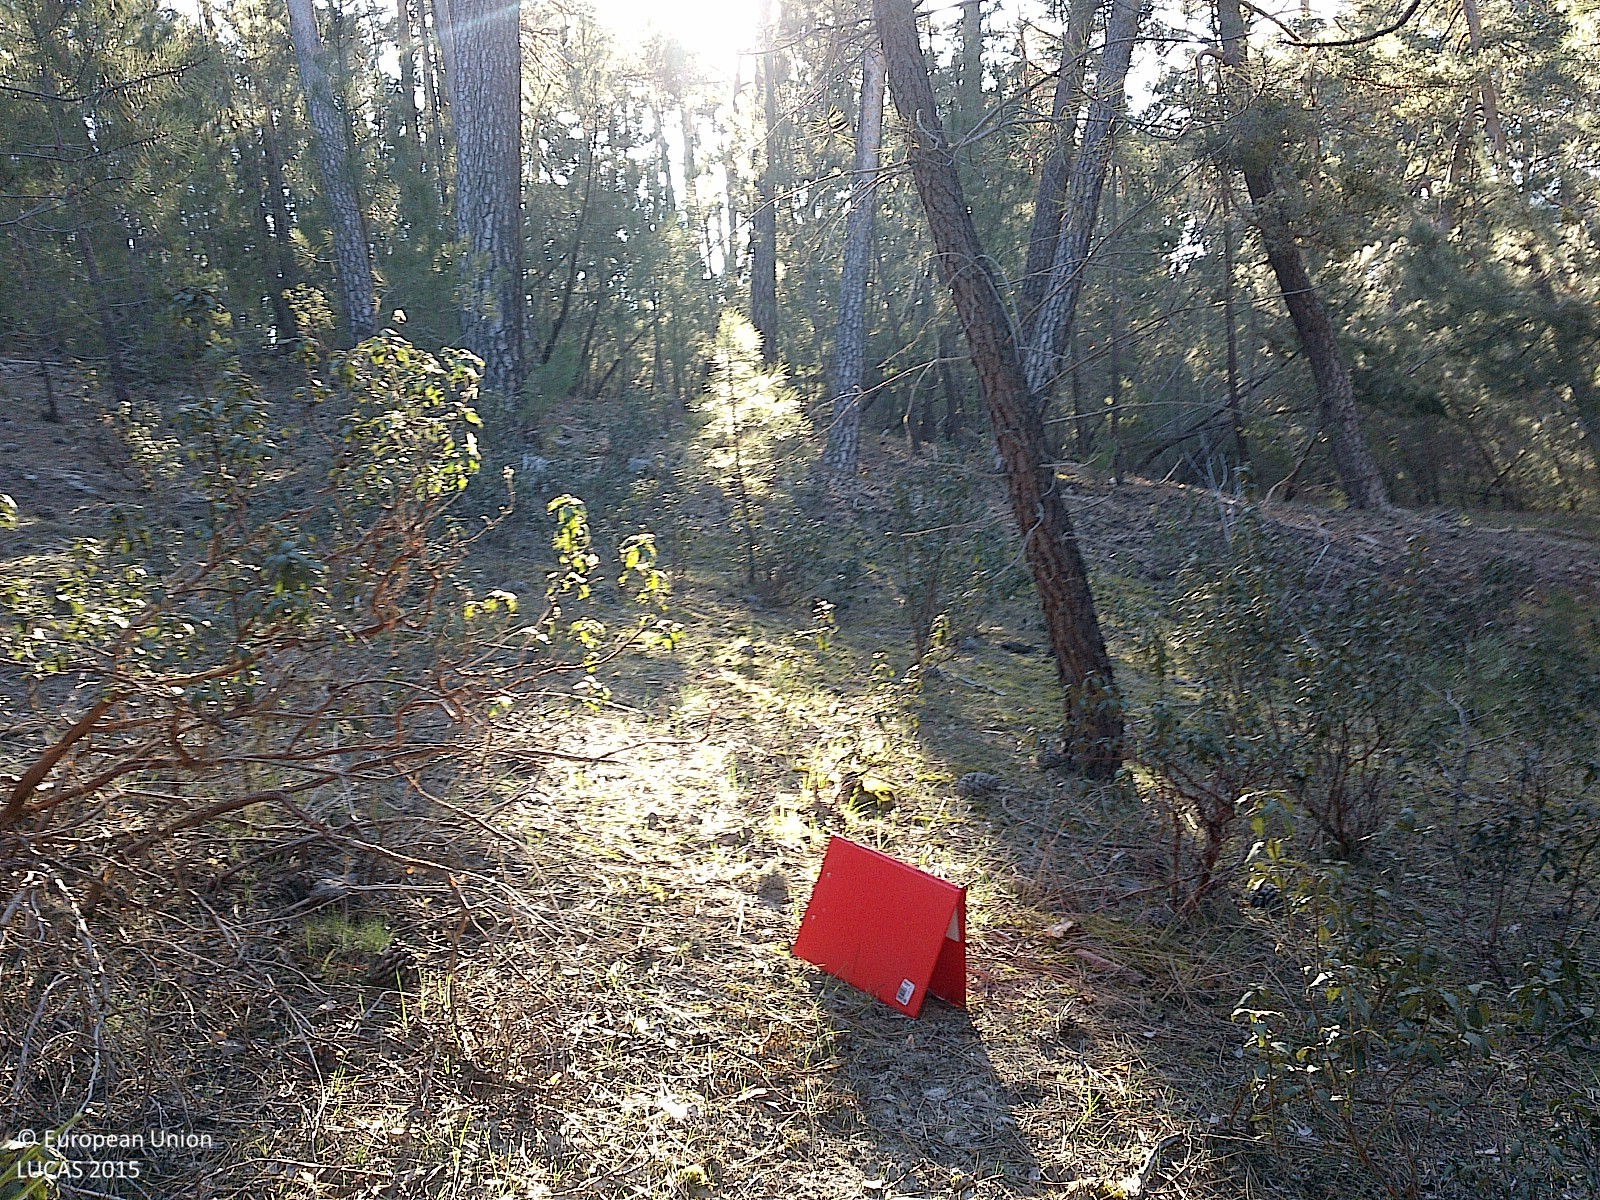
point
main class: Woodland
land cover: Pine dominated coniferous woodland
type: coniferous forest of the mediterranean region
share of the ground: 50 - 75 %
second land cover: Spontaneously vegetated surfaces
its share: 50 - 75 %
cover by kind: coniferous forest trees 85 %, herbaceous plants 10 %, shrubs 5 %
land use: Forestry
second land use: Agriculture (excluding fallow land and kitchen gardens)
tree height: > 5 m
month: April
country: ES
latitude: 41.8582
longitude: -3.0681
